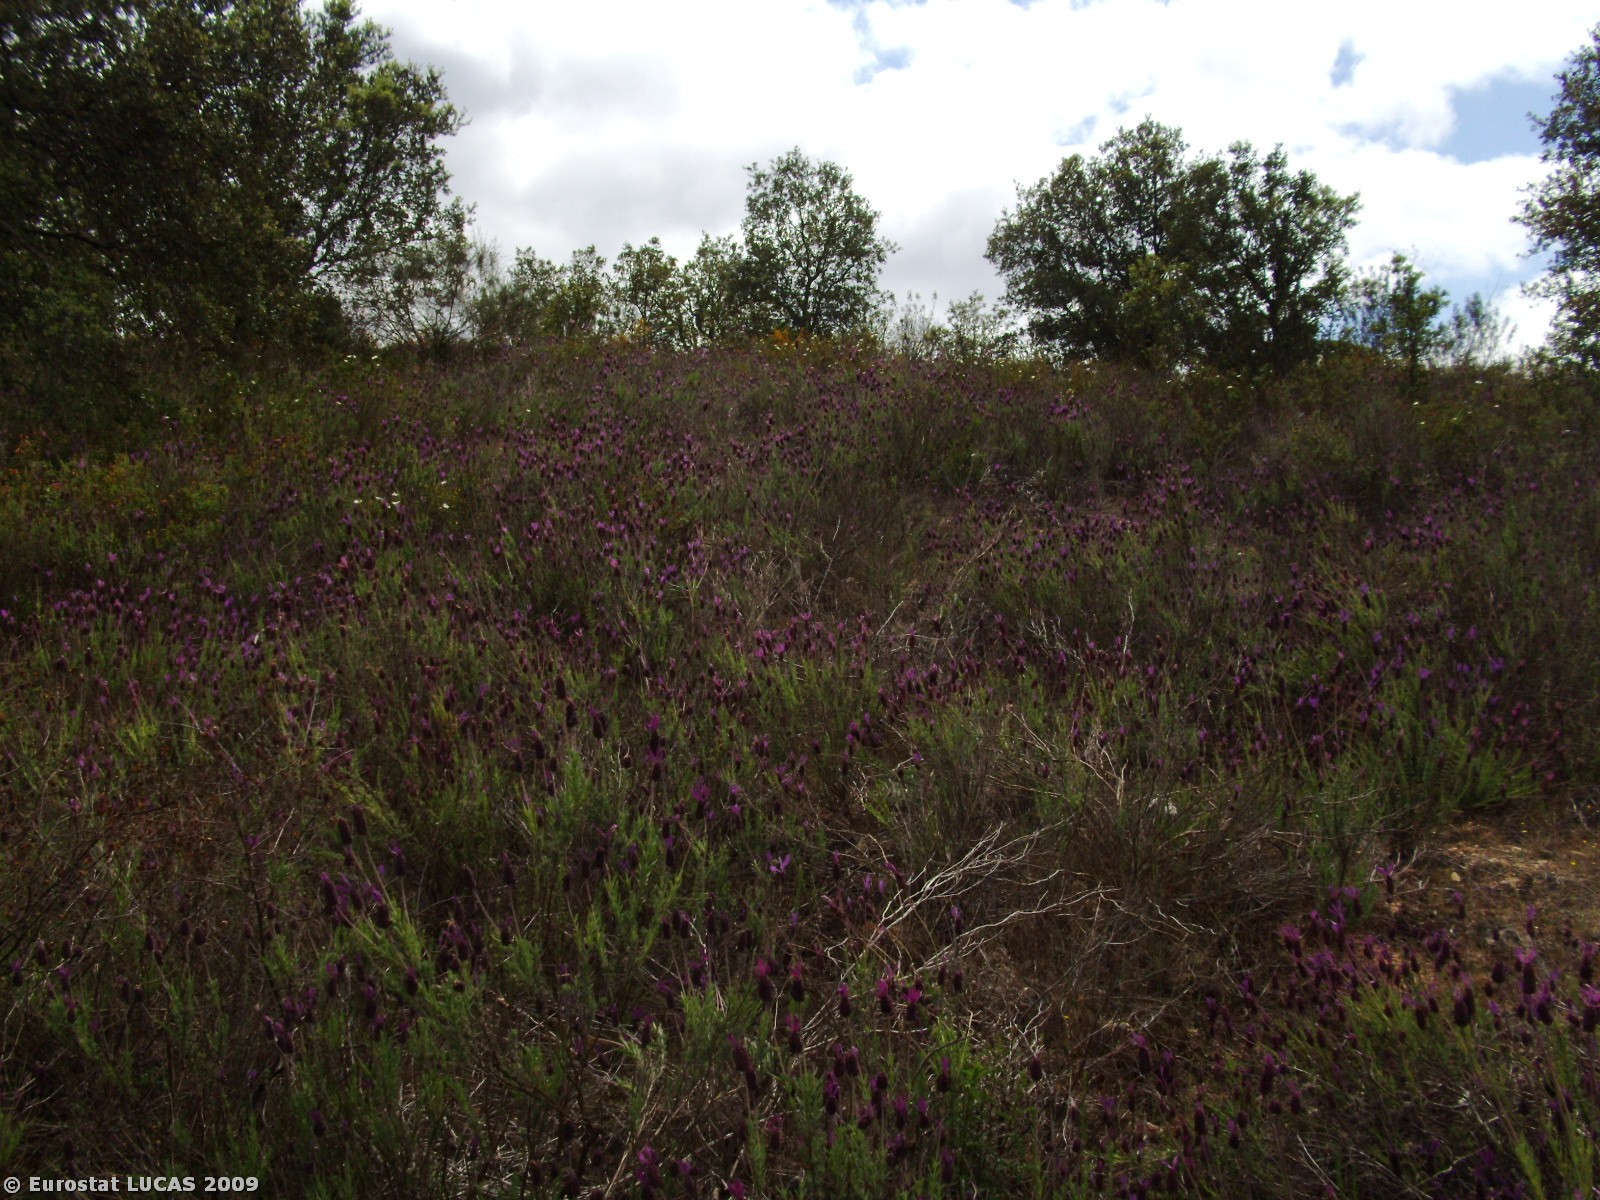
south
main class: Shrubland
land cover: Shrubland with sparse tree cover
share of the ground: > 75 %
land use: Nature reserves
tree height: > 5 m
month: April
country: PT
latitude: 39.7597
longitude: -7.4539
